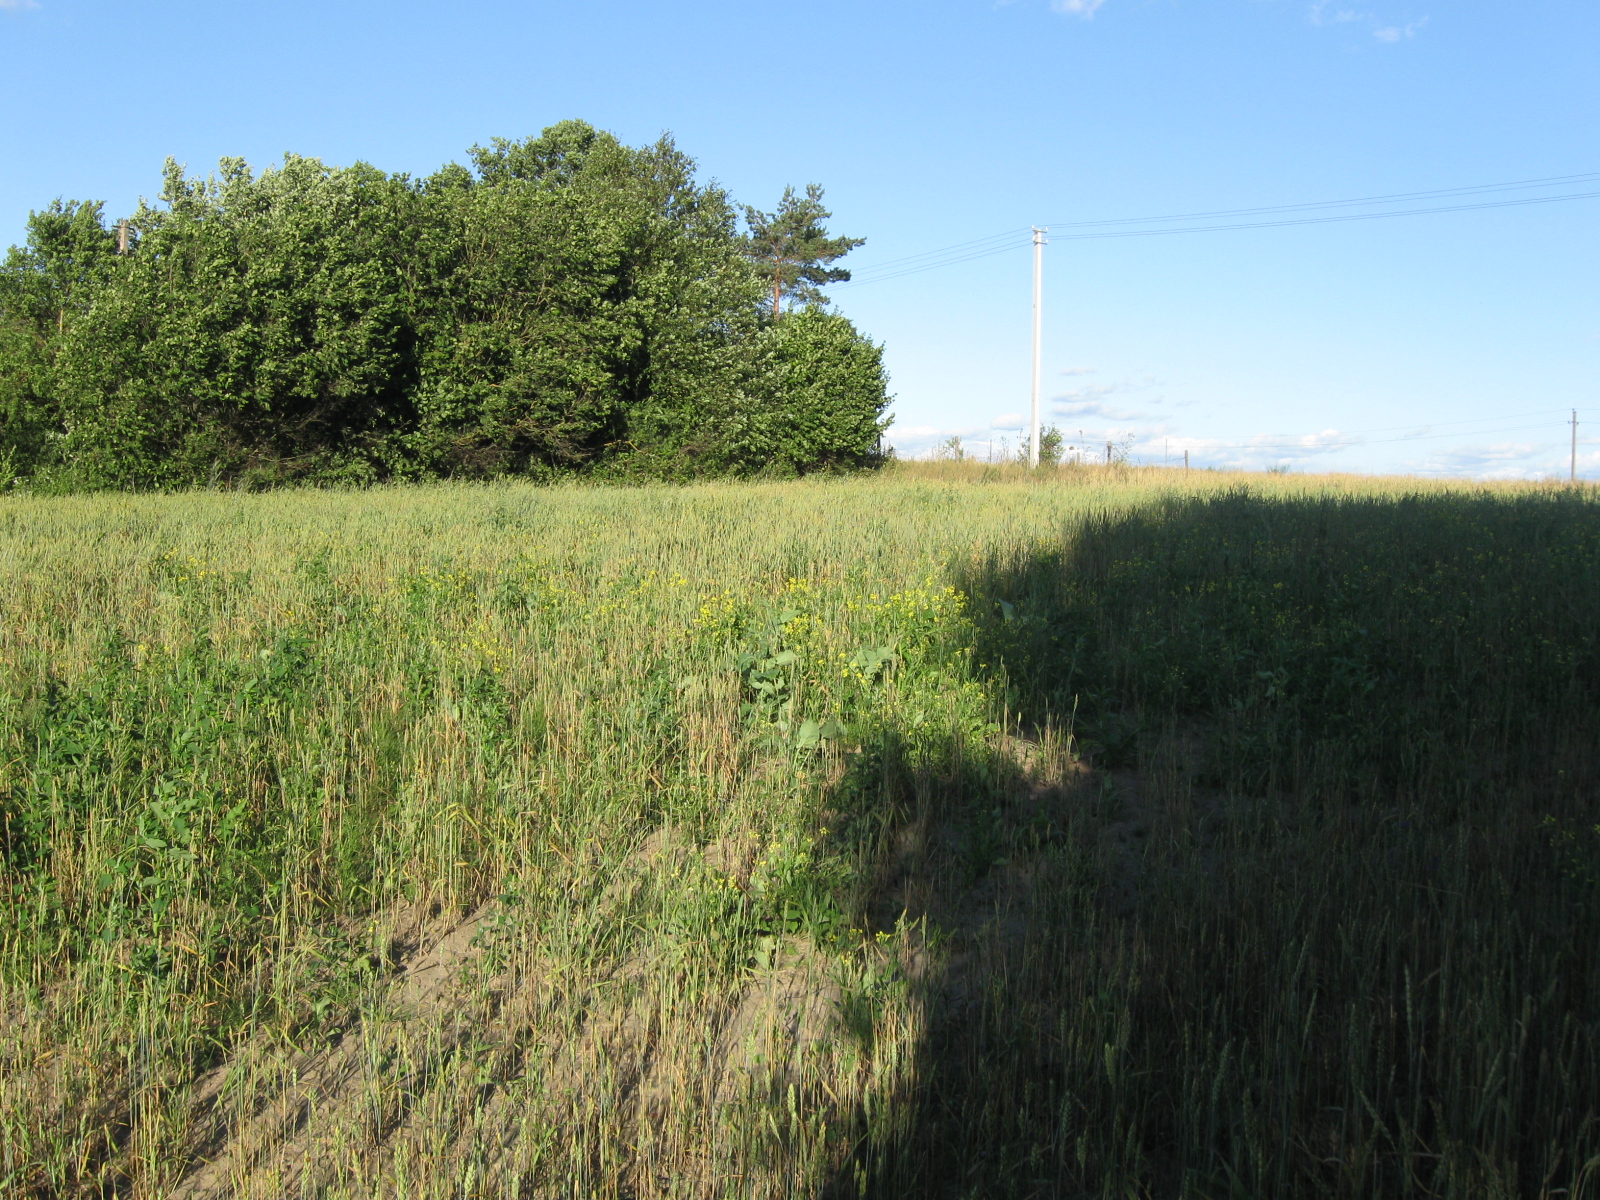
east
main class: Cropland
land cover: Common wheat
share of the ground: > 75 %
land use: Agriculture (excluding fallow land and kitchen gardens)
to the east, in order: Common wheat; Broadleaved woodland; Fences; Other fruit trees and berries; Grassland with sparse tree/shrub cover; Fences; Grassland with sparse tree/shrub cover; Electric lines; Broadleaved woodland; Fences; Broadleaved woodland; Paved roads, cycling and walking lanes; Shruby margins; Common wheat; Spontaneously vegetated surfaces; Artificial constructions in urban areas
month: July
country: LT
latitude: 54.8726
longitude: 23.7846
